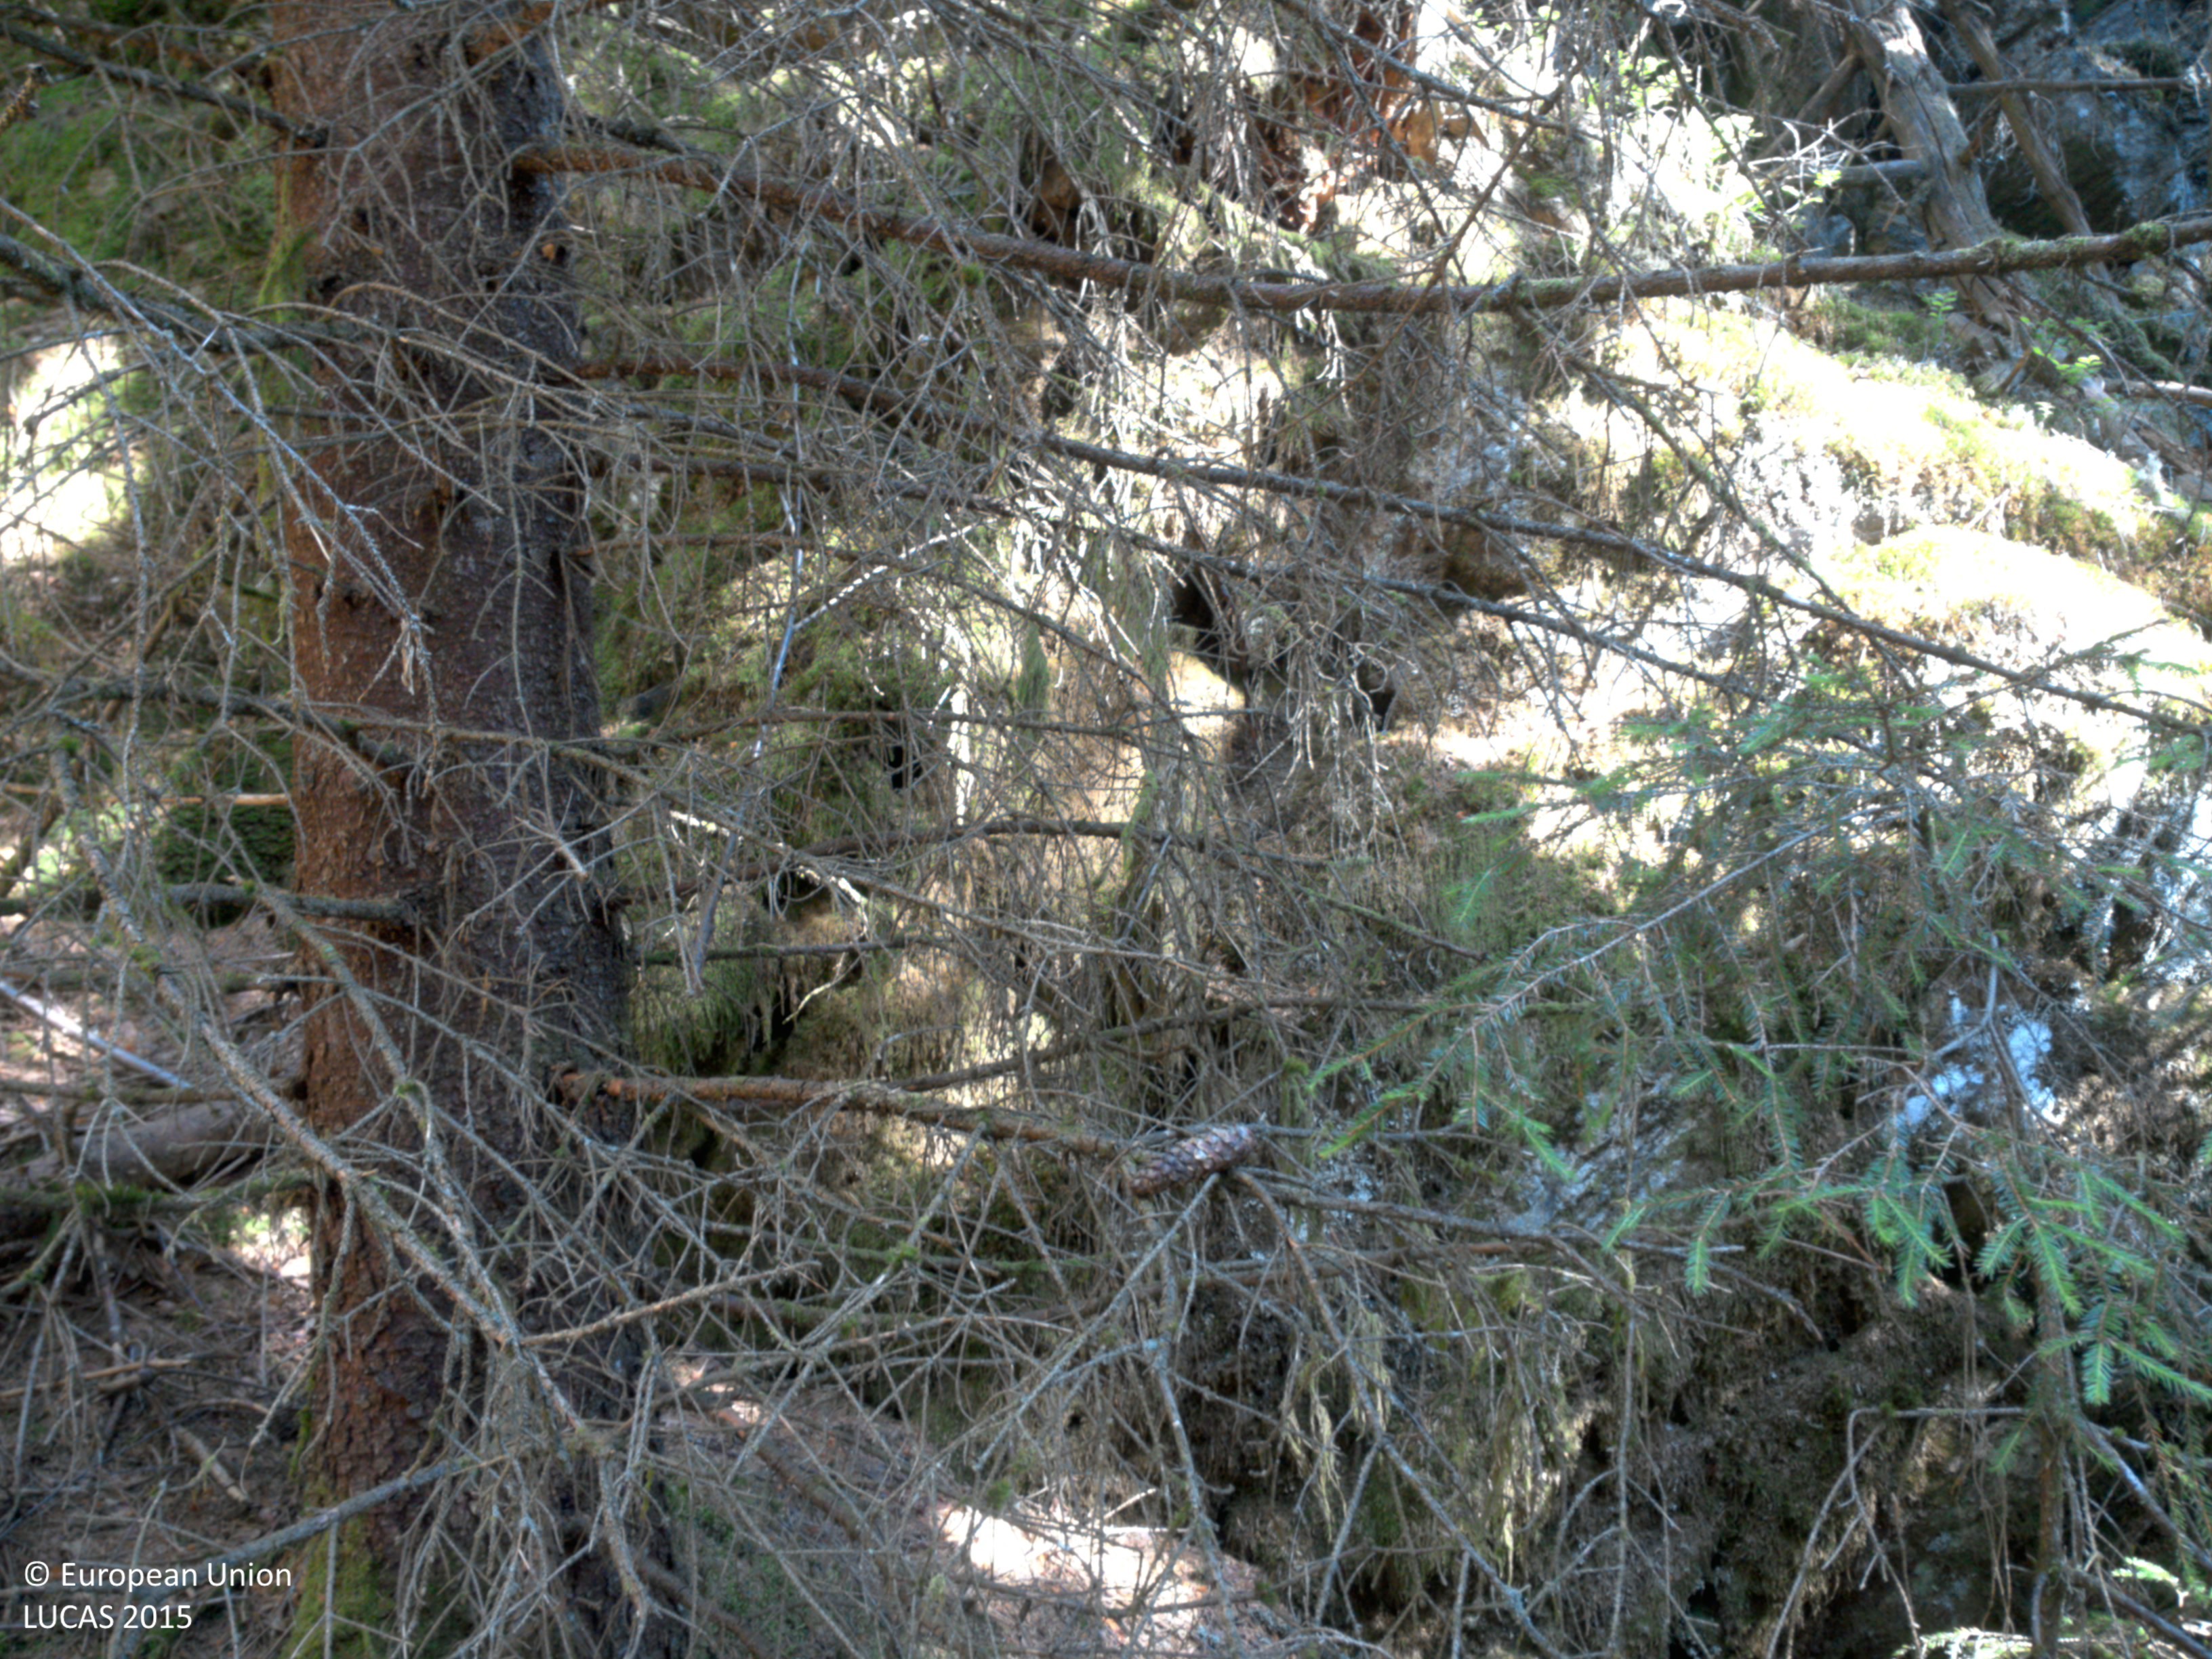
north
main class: Woodland
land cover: Spruce dominated coniferous woodland
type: boreal forest
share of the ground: > 75 %
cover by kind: coniferous forest trees 75 %, lichens and mosses 20 %, broadleaved forest trees 5 %
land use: Forestry
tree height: > 5 m
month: July
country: SE
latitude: 58.4764
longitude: 11.8652
